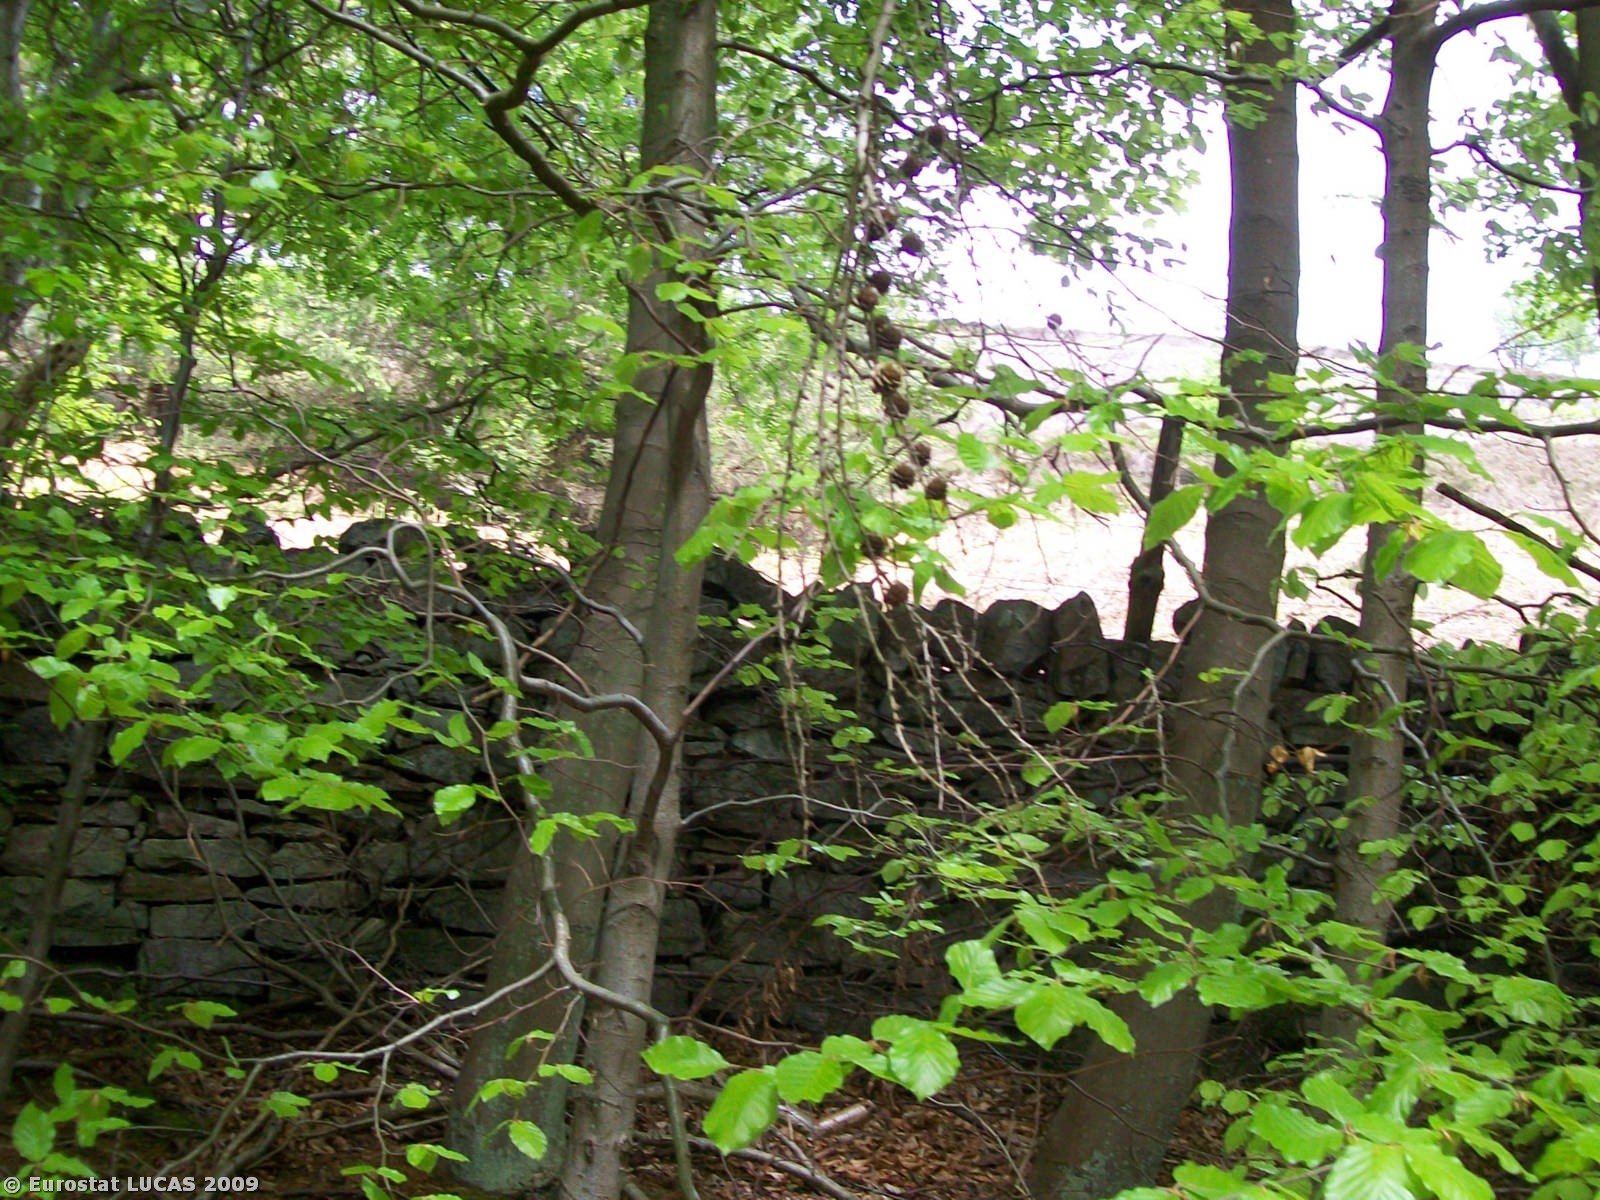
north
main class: Woodland
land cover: Mixed woodland
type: acidophilous oak and oak-birch forest
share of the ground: 10 - 25 %
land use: Forestry
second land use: Nature reserves
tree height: > 5 m
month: May
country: GB
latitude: 54.6661
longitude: -1.9149
